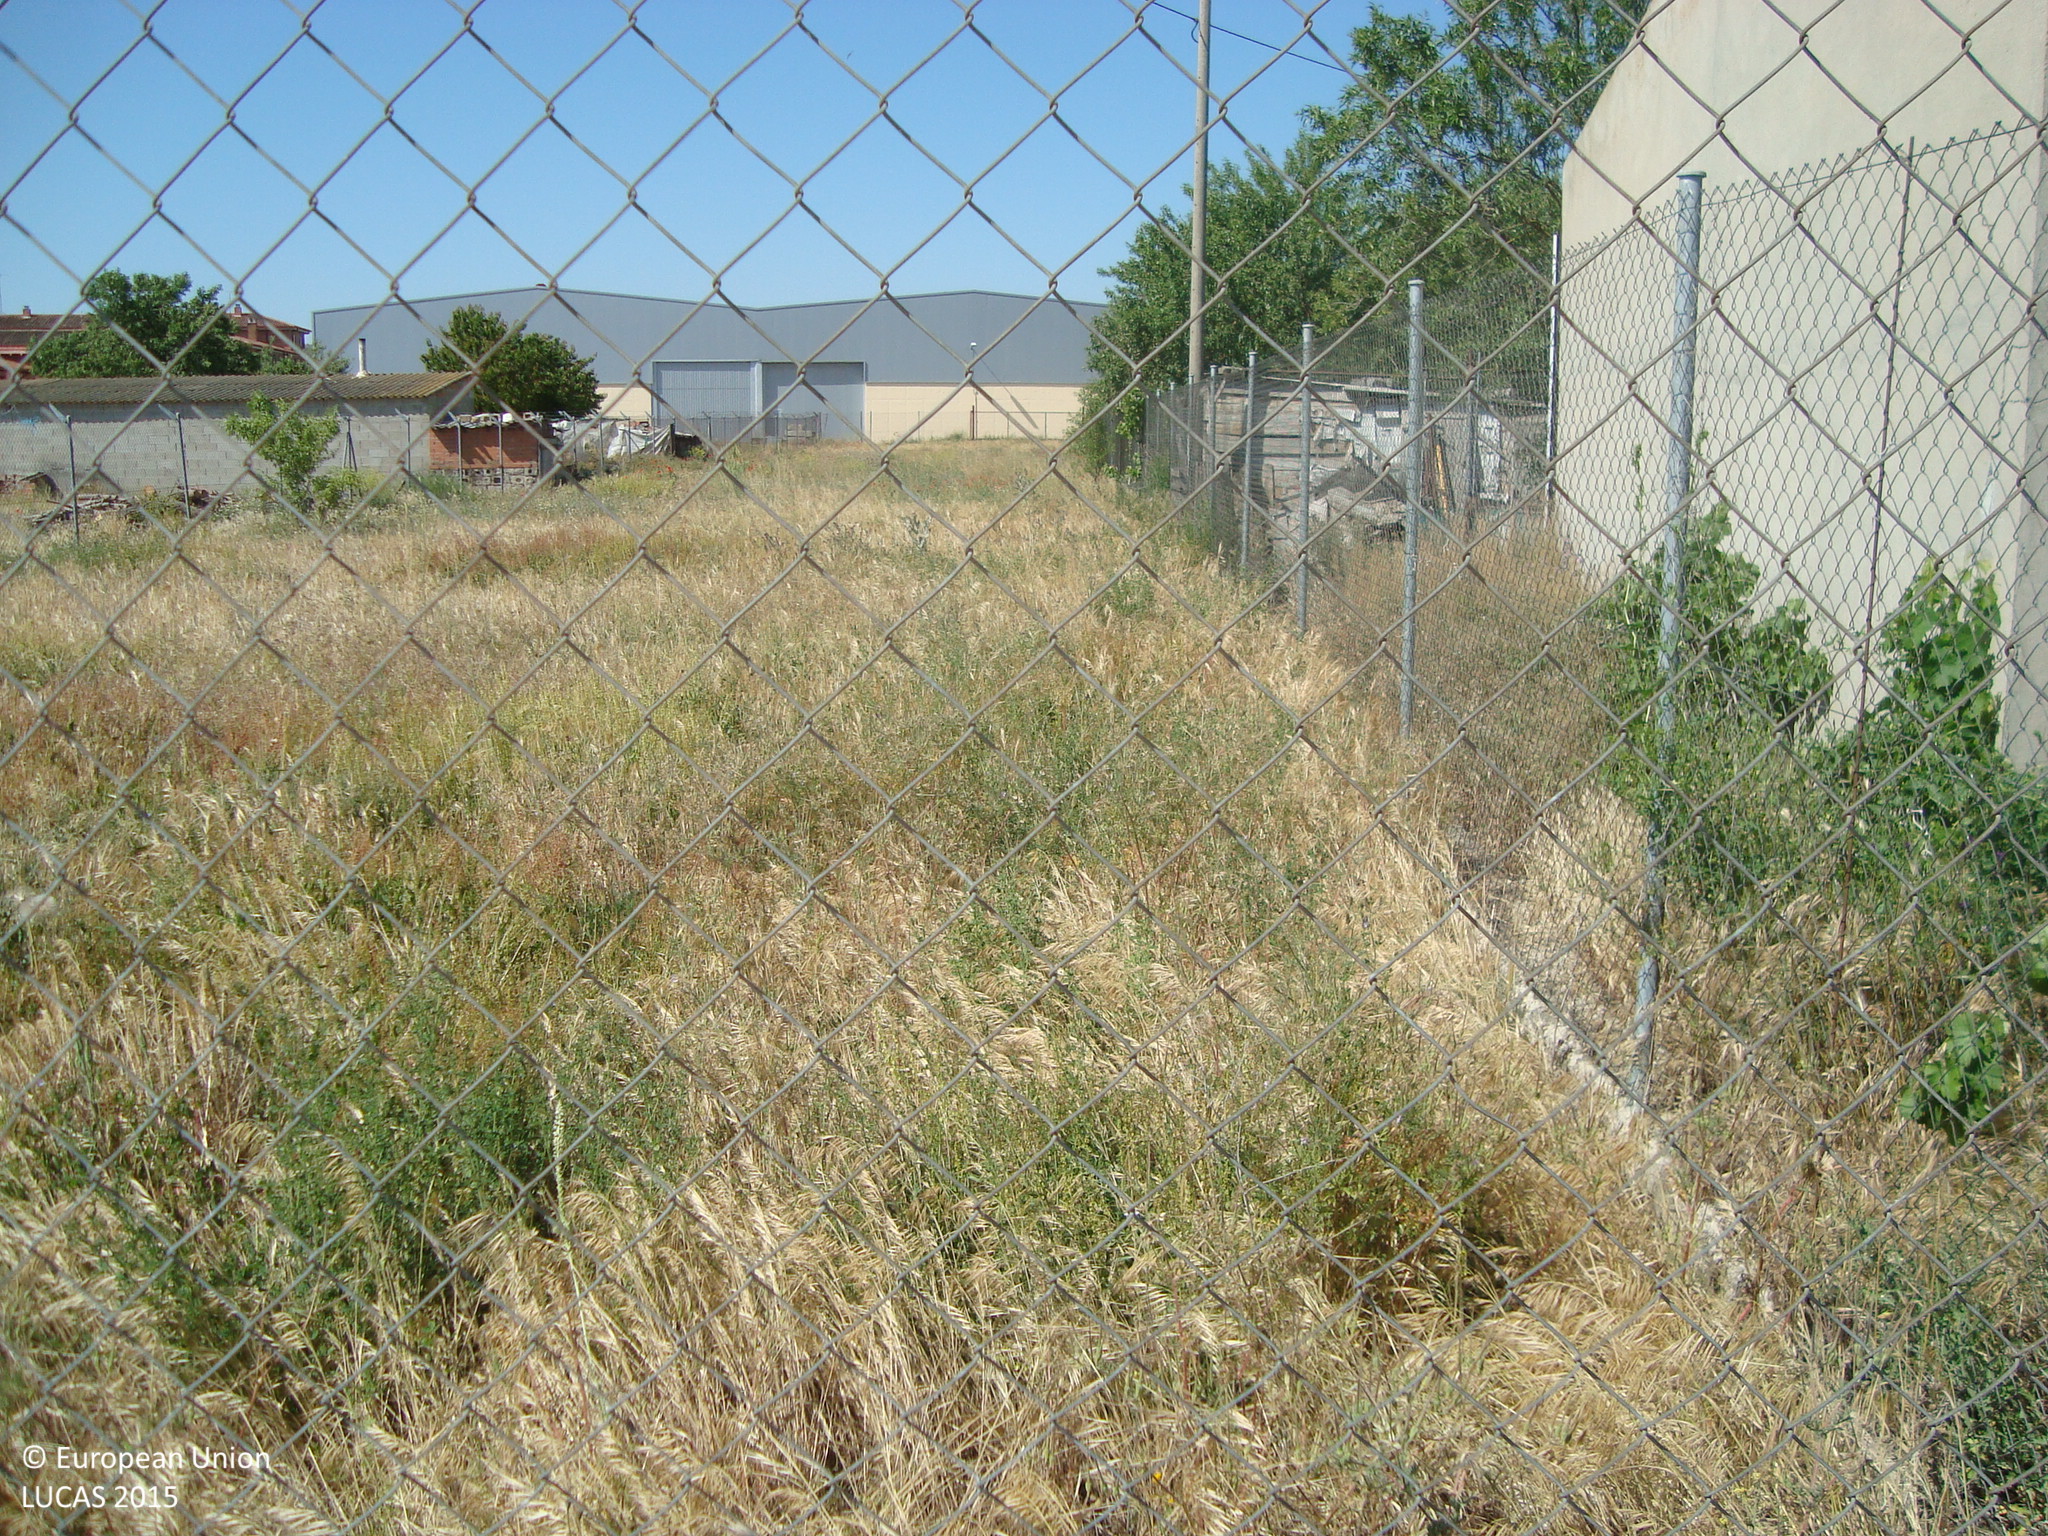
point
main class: Grassland
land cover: Grassland without tree/shrub cover
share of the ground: > 75 %
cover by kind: herbaceous plants 90 %, shrubs 5 %, unconsolidated bare surface 5 %
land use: Abandoned areas
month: May
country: ES
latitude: 41.6025
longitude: -4.1328
